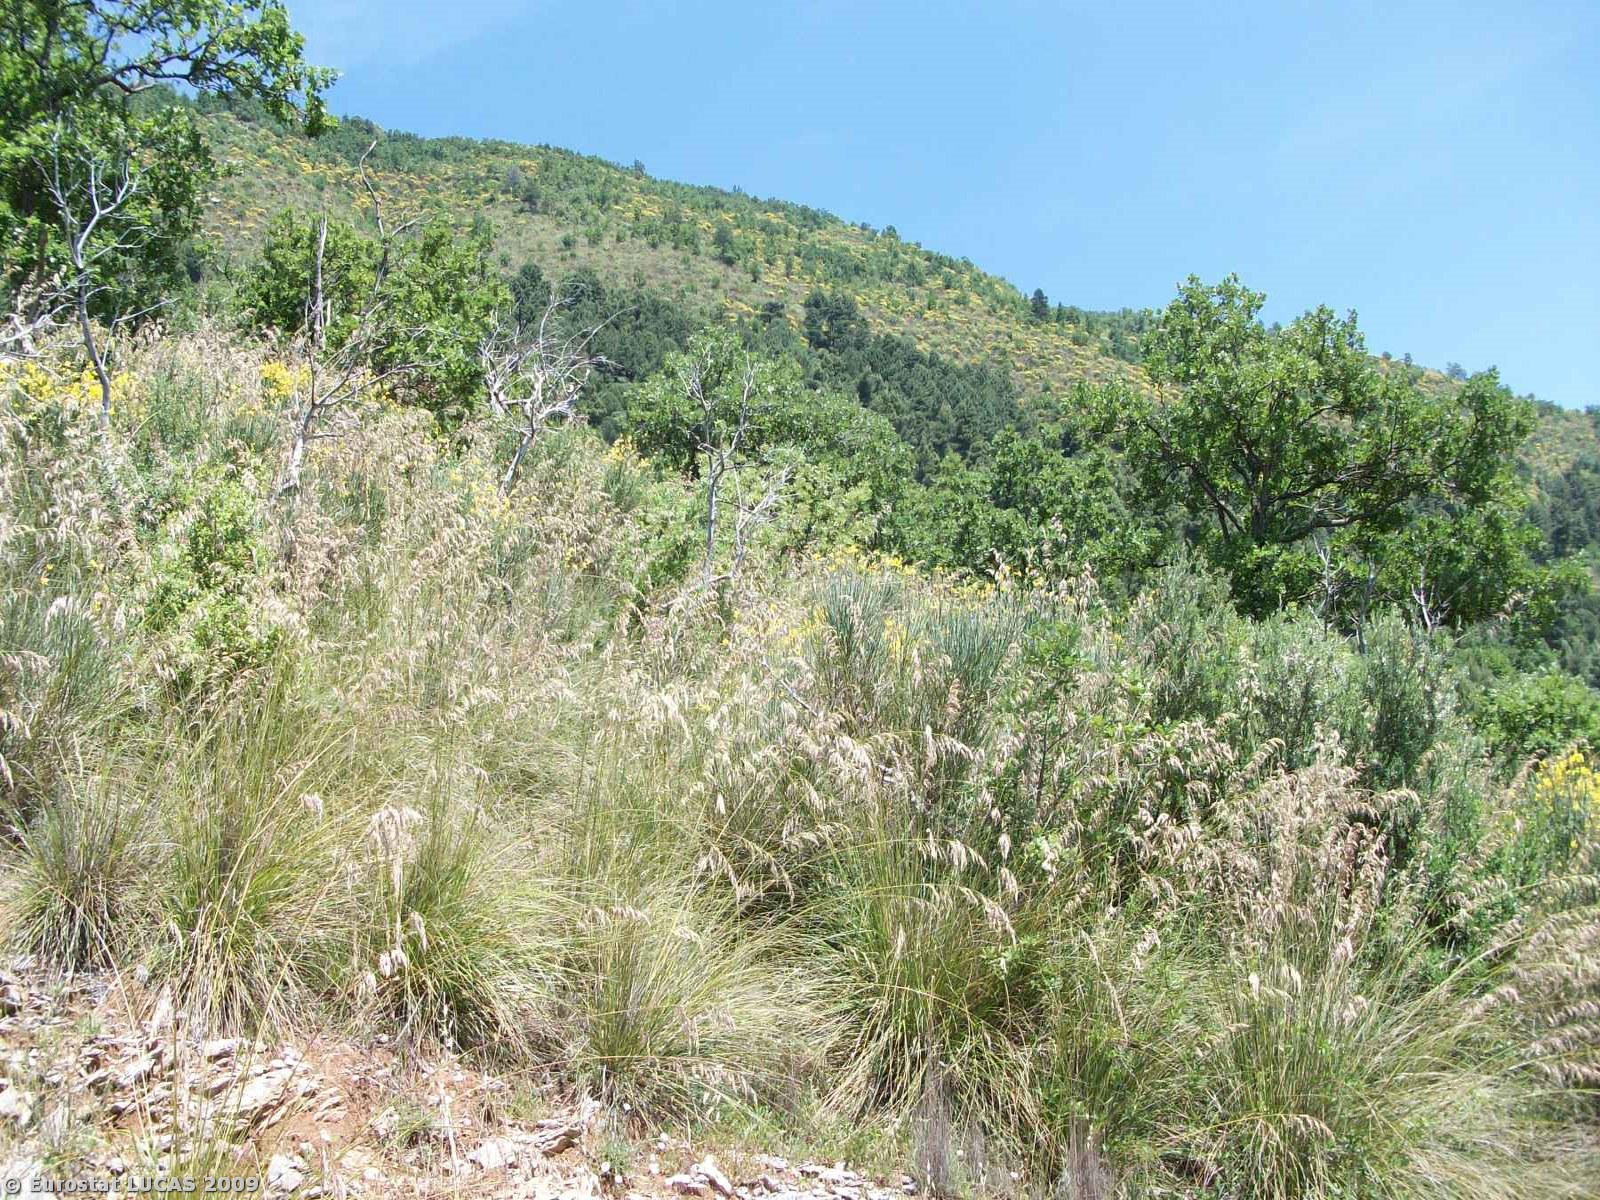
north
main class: Shrubland
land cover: Shrubland without tree cover
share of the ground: 50 - 75 %
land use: Nature reserves
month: June
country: IT
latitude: 39.6648
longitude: 16.0218
